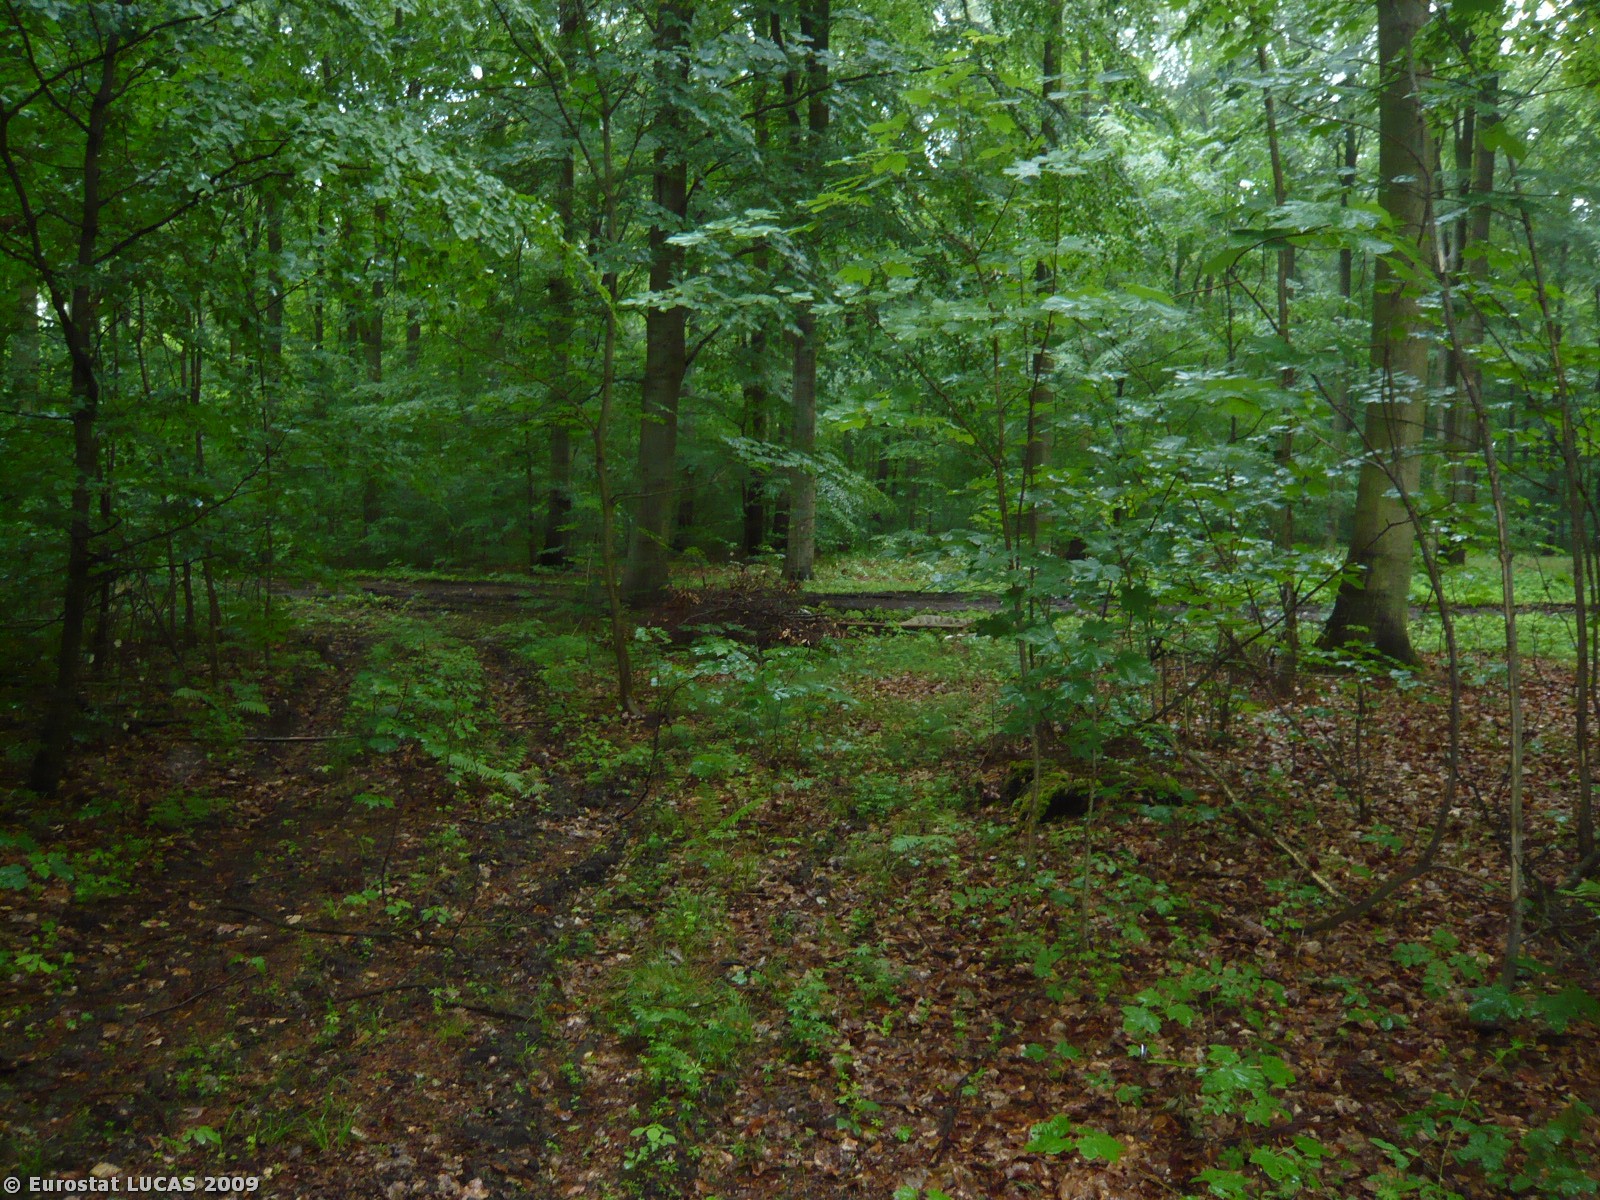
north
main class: Woodland
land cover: Broadleaved woodland
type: mesophytic deciduous forest
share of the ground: > 75 %
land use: Forestry
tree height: > 5 m
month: June
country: DK
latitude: 54.8255
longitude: 11.8822
